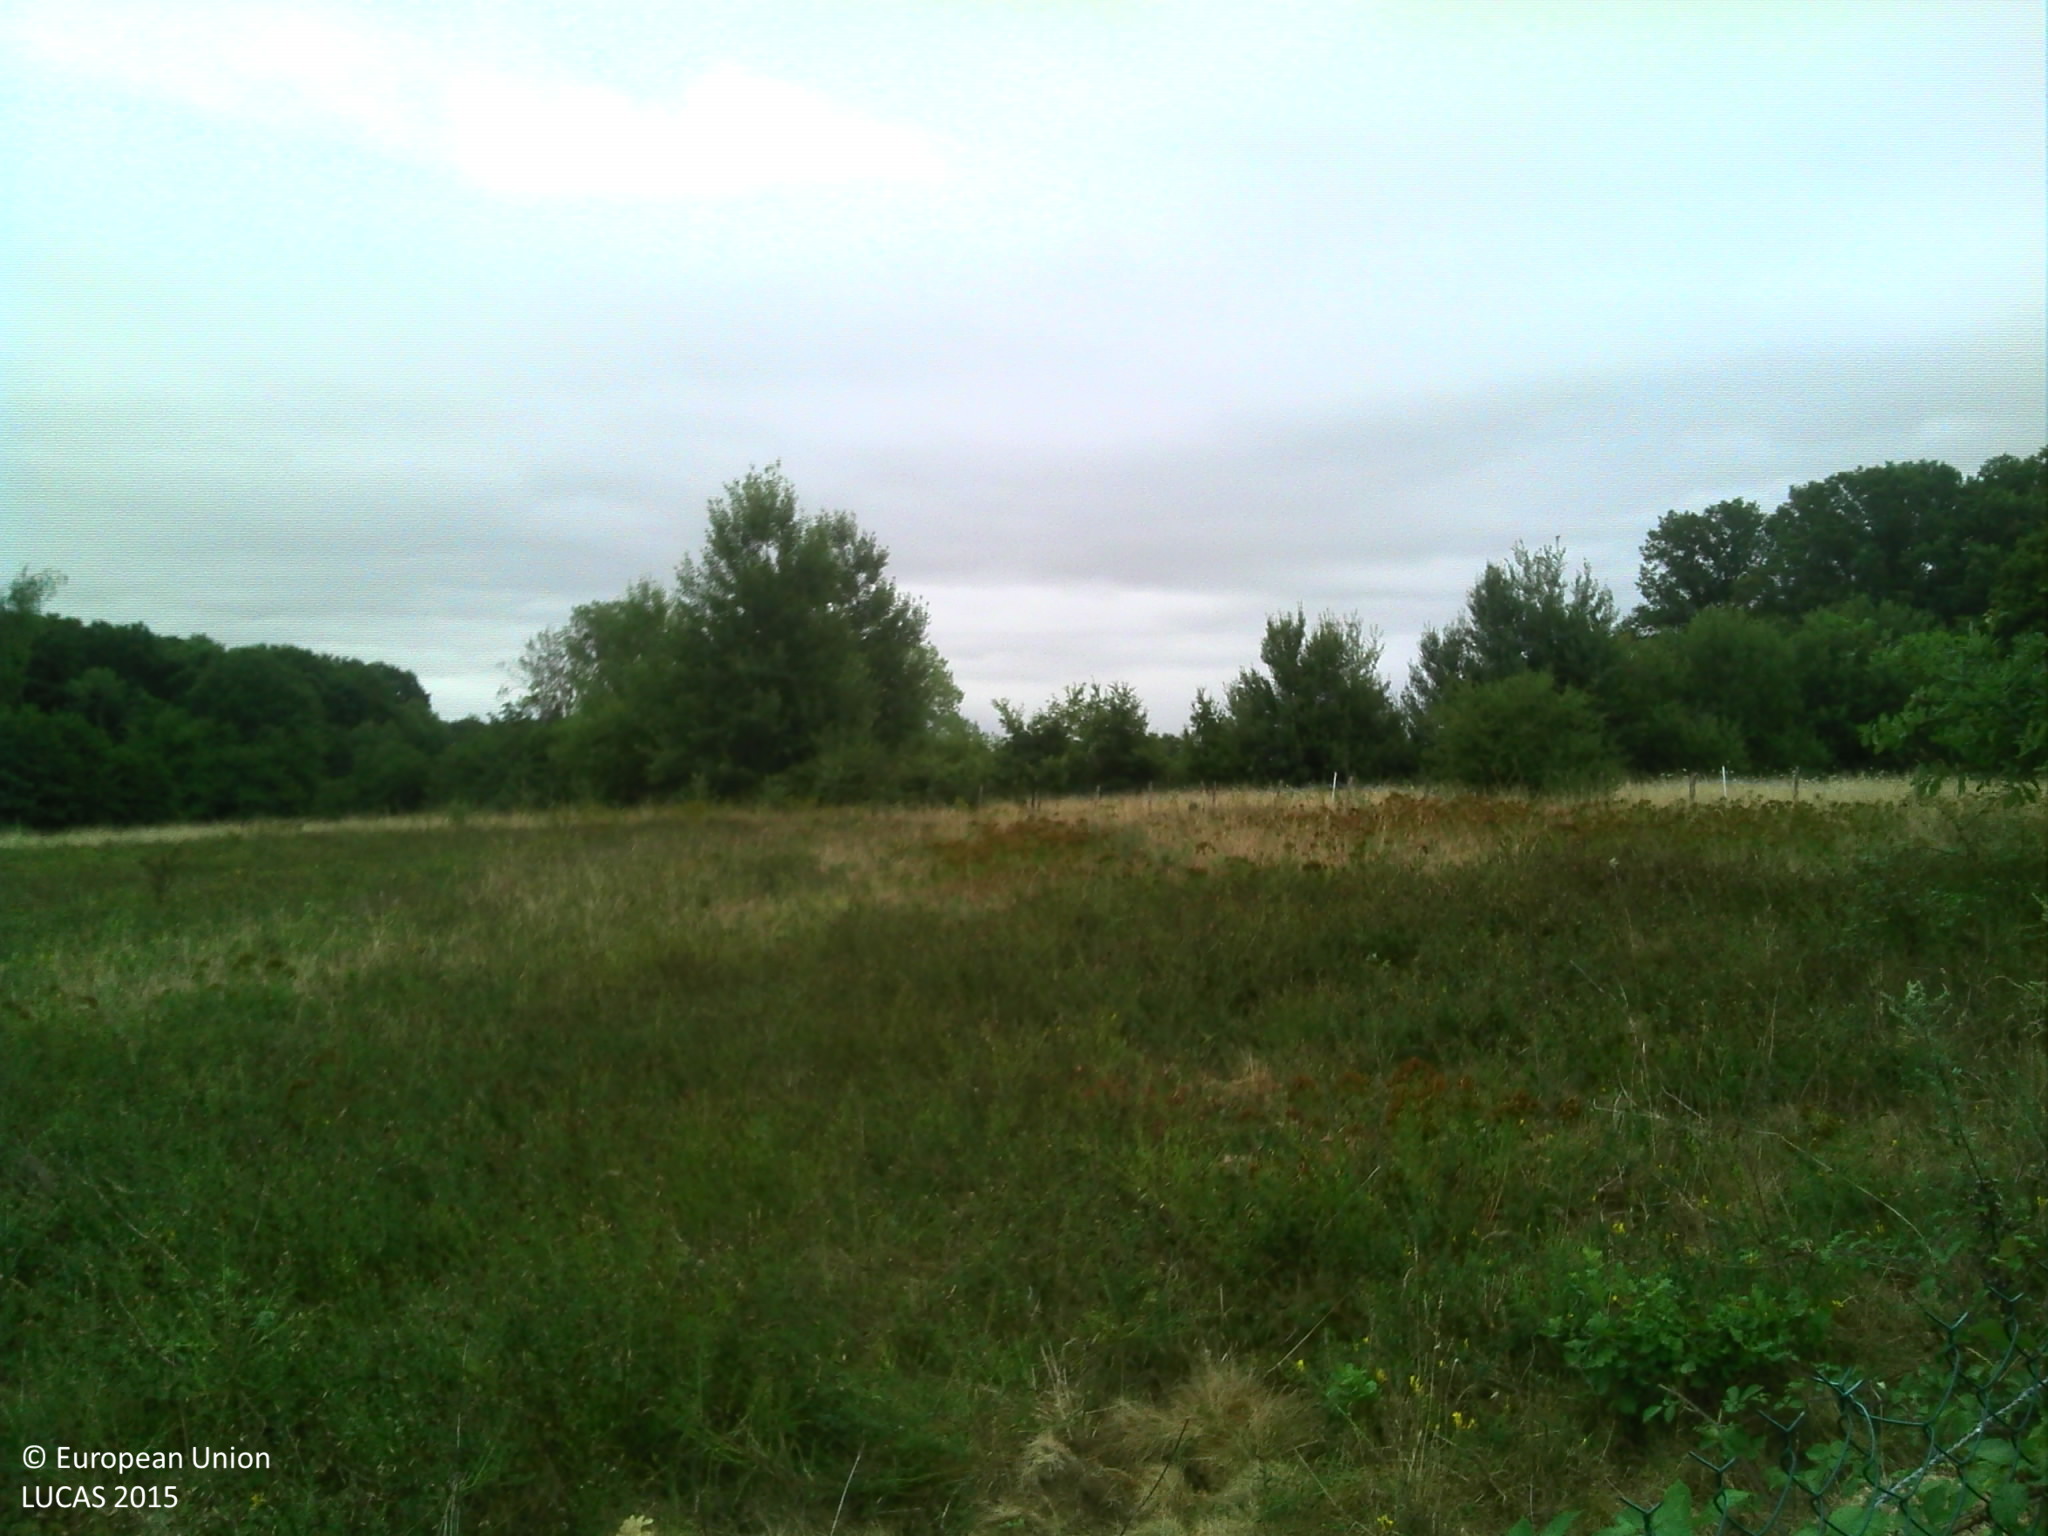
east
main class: Grassland
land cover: Spontaneously vegetated surfaces
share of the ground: > 75 %
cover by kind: herbaceous plants 100 %
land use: Abandoned areas
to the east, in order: Fences; Spontaneously vegetated surfaces; Grassland without tree/shrub cover; Broadleaved woodland; Rivers and streams; Broadleaved woodland; Spontaneously vegetated surfaces
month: July
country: FR
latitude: 46.6731
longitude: 5.1261
